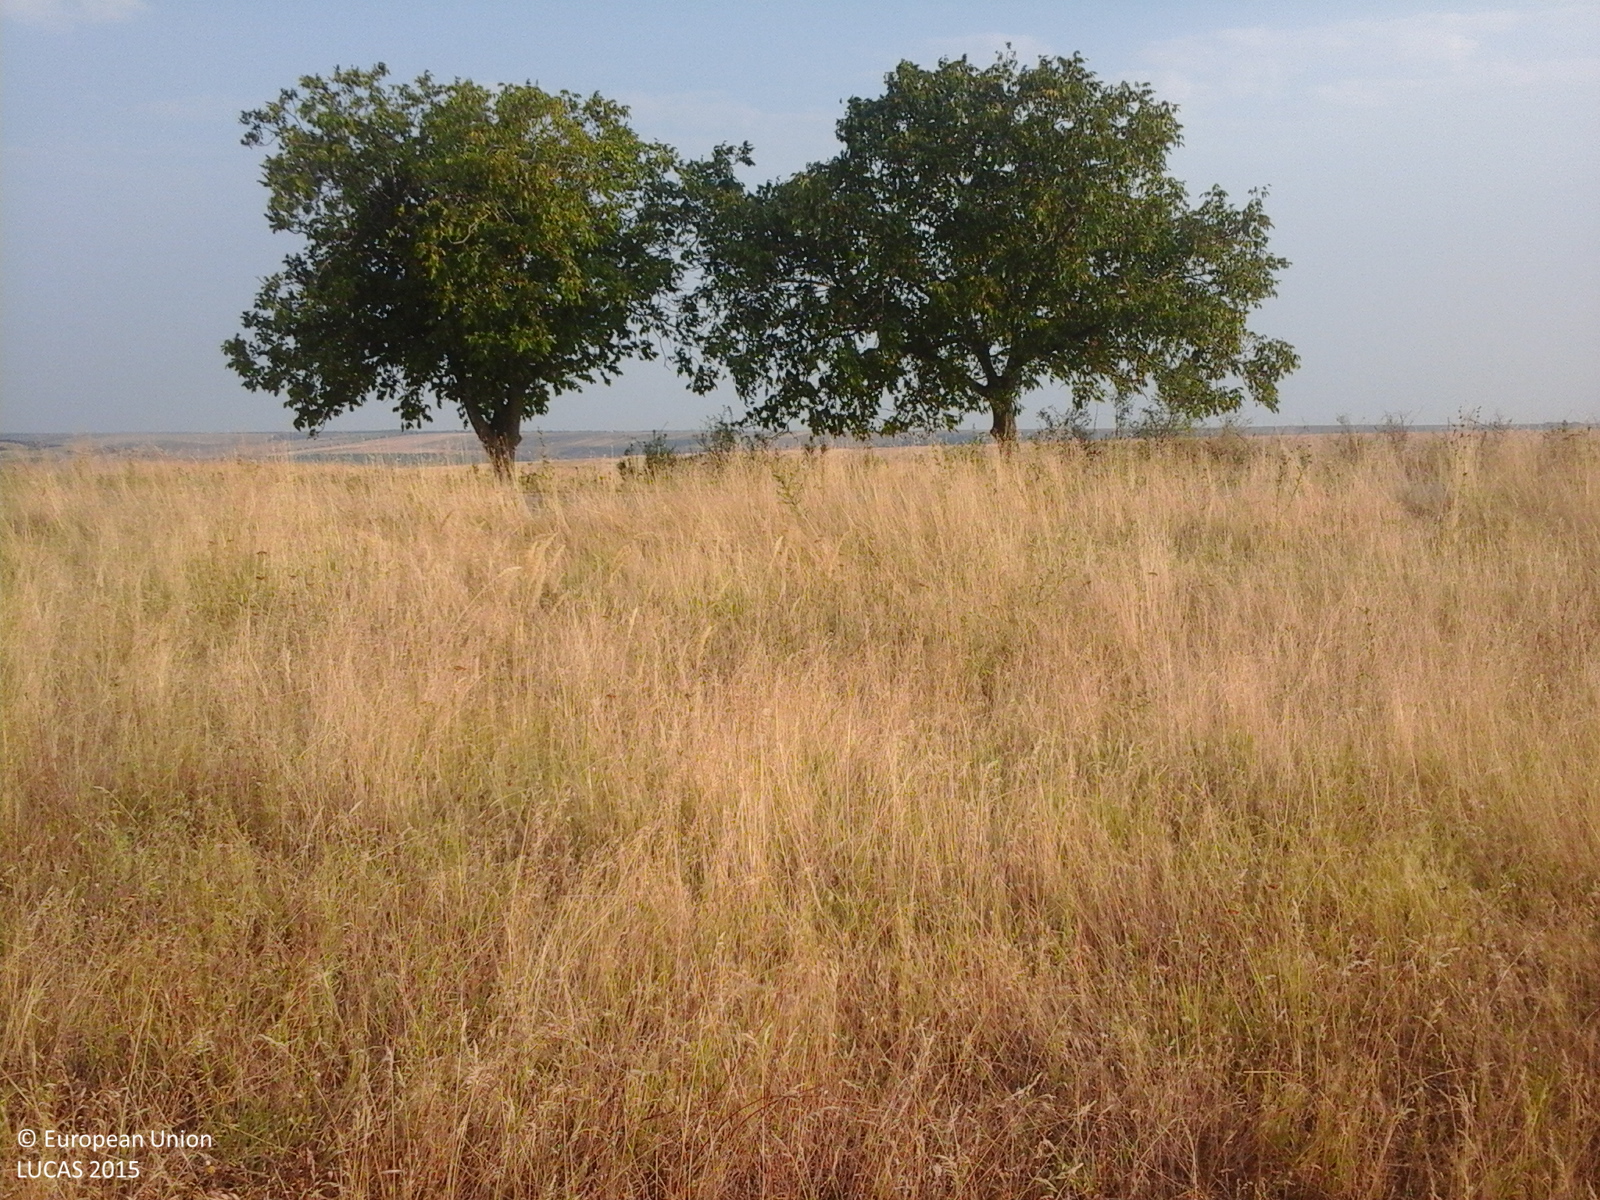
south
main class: Grassland
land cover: Grassland without tree/shrub cover
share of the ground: > 75 %
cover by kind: herbaceous plants 100 %
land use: Agriculture (excluding fallow land and kitchen gardens)
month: August
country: RO
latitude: 44.4414
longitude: 22.9989
